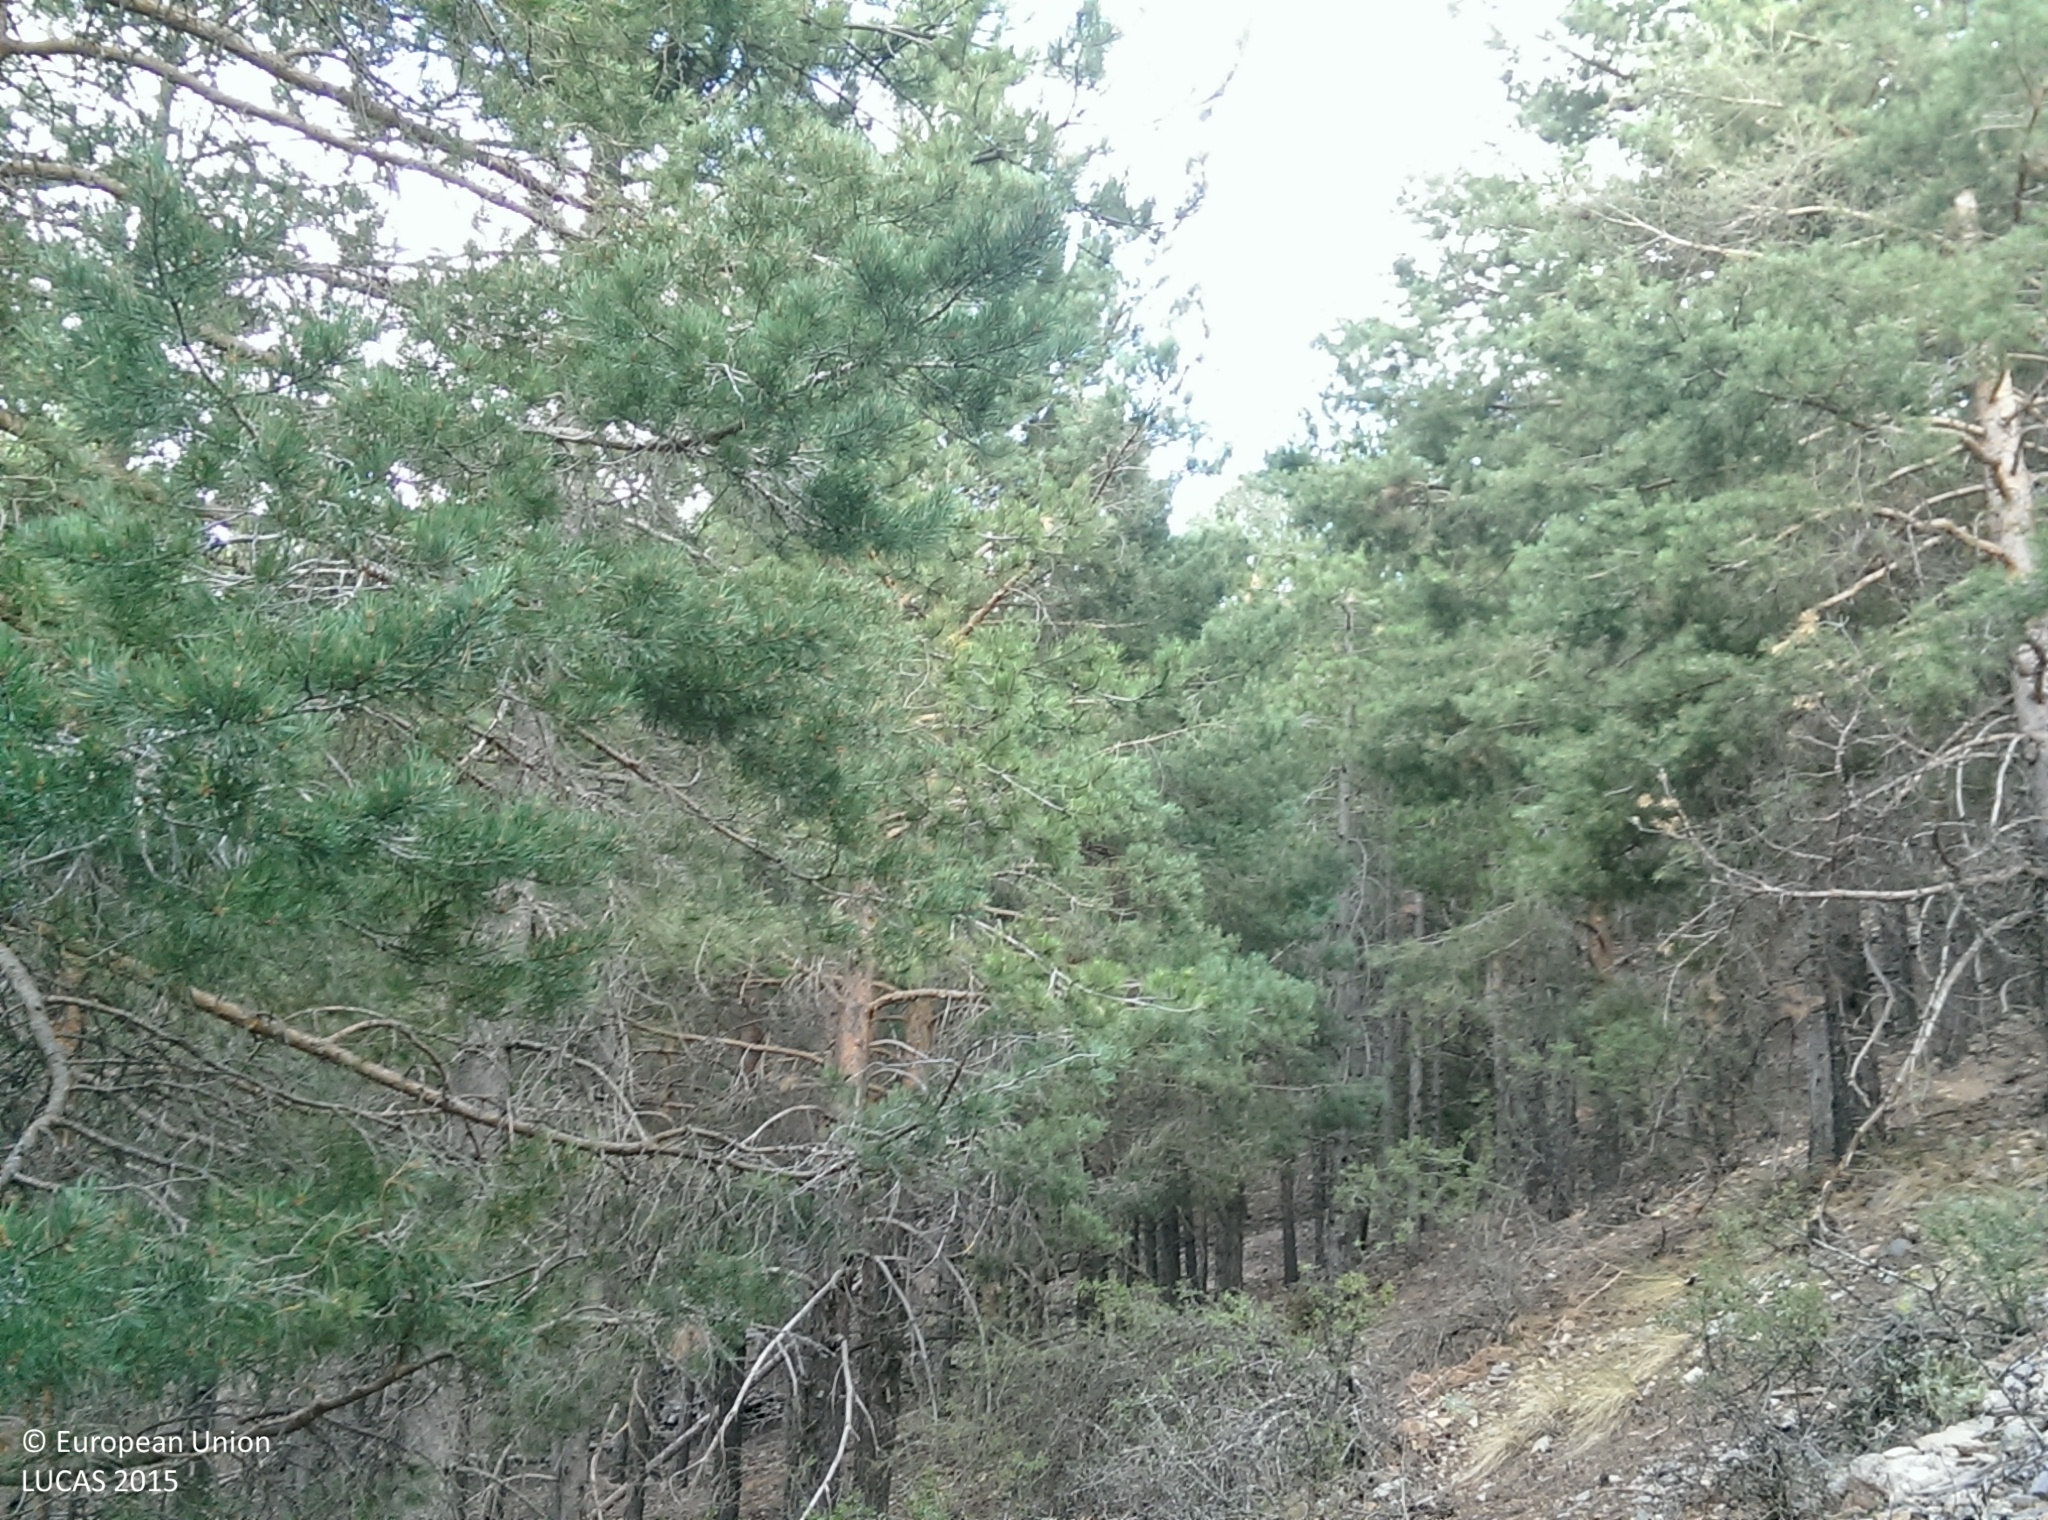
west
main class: Woodland
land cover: Pine dominated coniferous woodland
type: coniferous forest of the mediterranean region
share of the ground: > 75 %
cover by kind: coniferous forest trees 80 %, shrubs 10 %, consolidated bare surface 5 %, unconsolidated bare surface 5 %
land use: Forestry
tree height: > 5 m
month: July
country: ES
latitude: 37.3613
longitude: -2.8913
